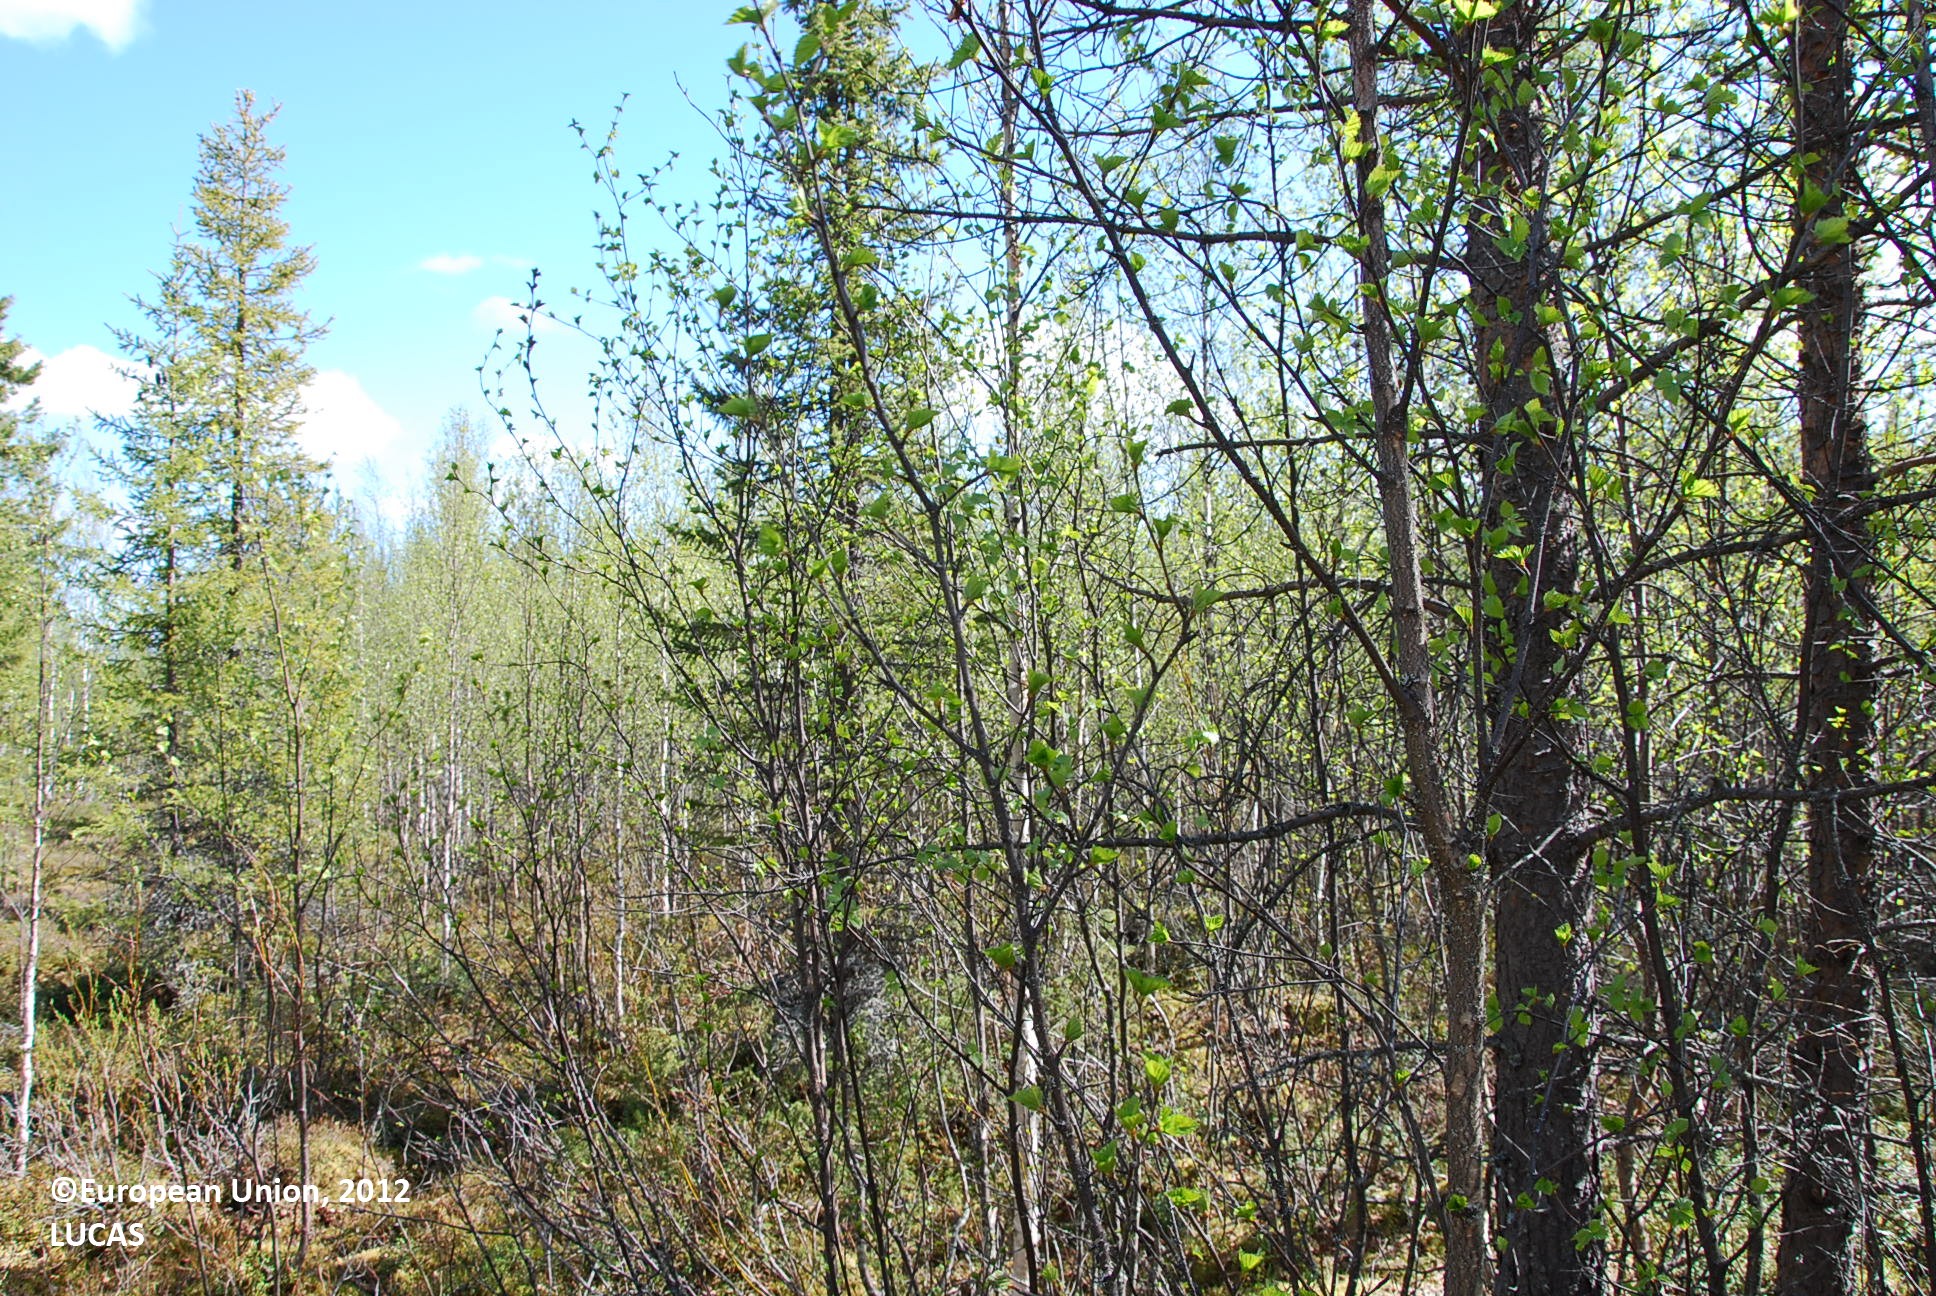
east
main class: Woodland
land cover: Other mixed woodland
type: boreal forest
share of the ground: > 75 %
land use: Forestry
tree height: > 5 m
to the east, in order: Other mixed woodland; Pine dominated mixed woodland; Other mixed woodland; Pine dominated mixed woodland; Other mixed woodland
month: June
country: FI
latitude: 67.0064
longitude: 28.0863
